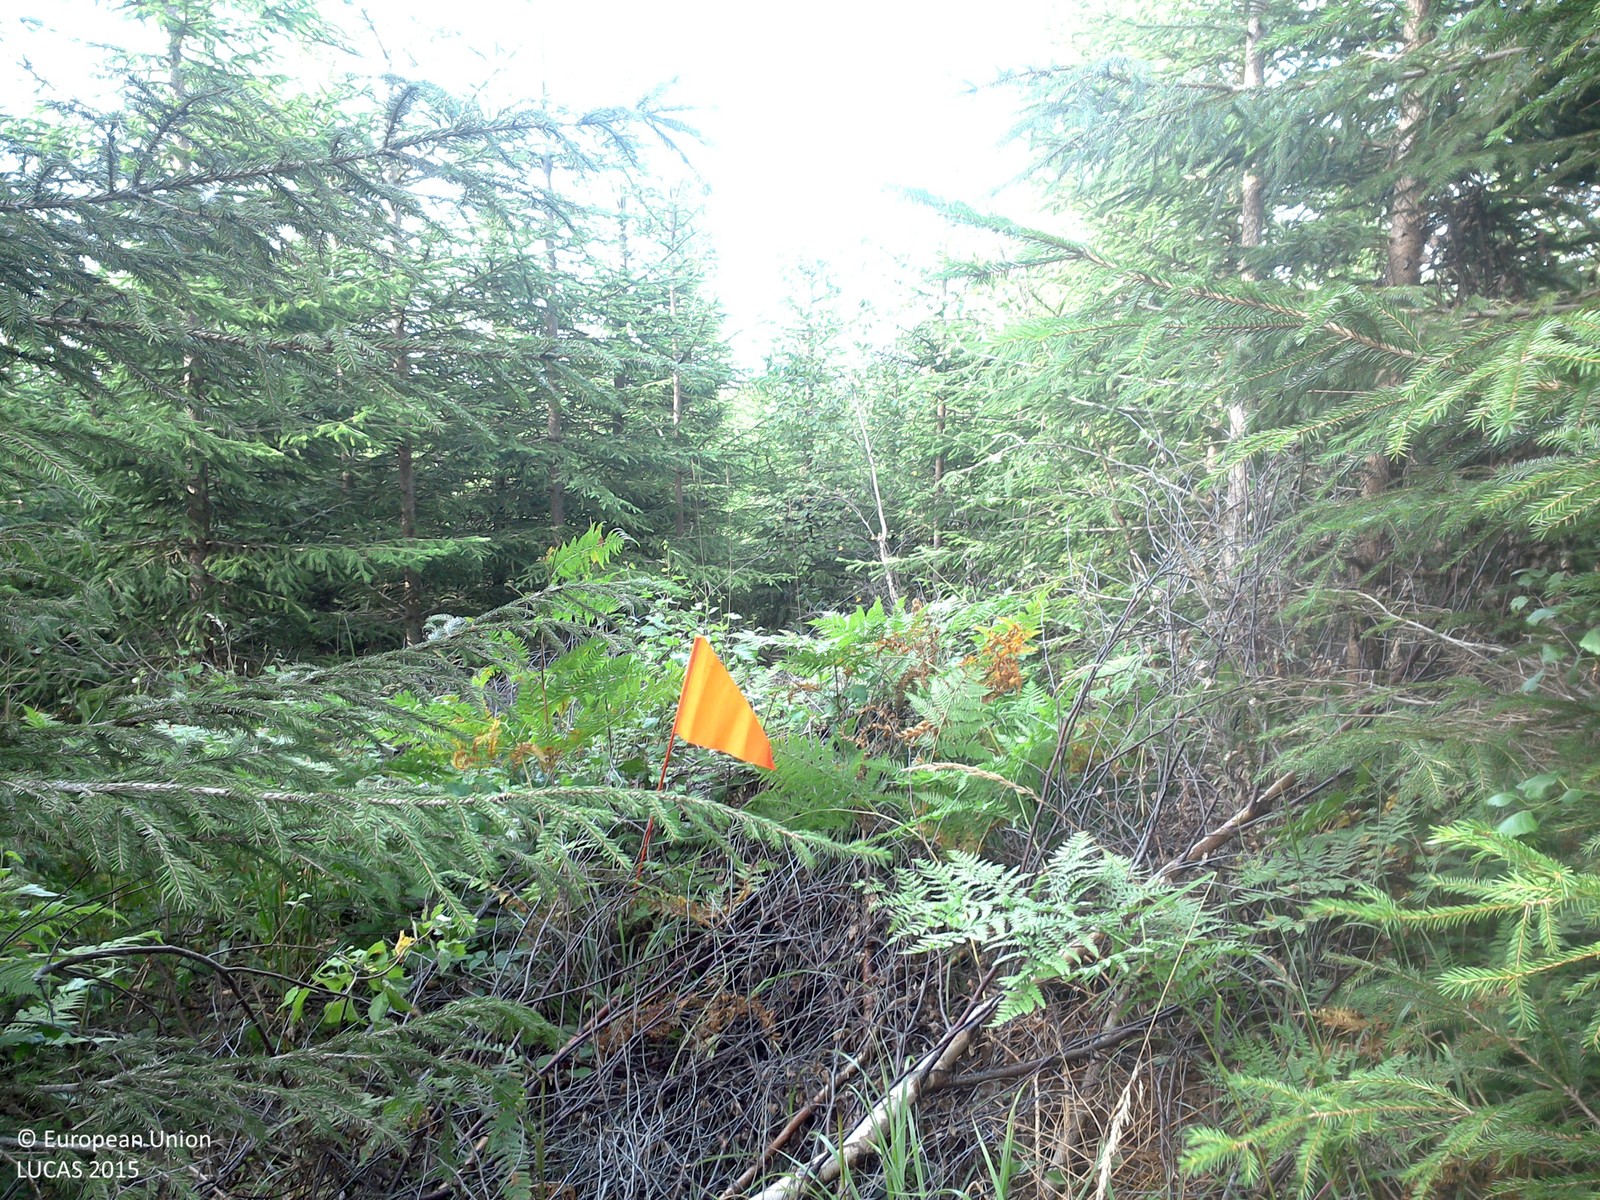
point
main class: Woodland
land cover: Spruce dominated coniferous woodland
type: boreal forest
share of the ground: 50 - 75 %
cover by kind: coniferous forest trees 75 %, herbaceous plants 20 %, lichens and mosses 5 %
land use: Forestry
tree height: < 5 m
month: August
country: SE
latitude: 57.7908
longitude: 15.2944
